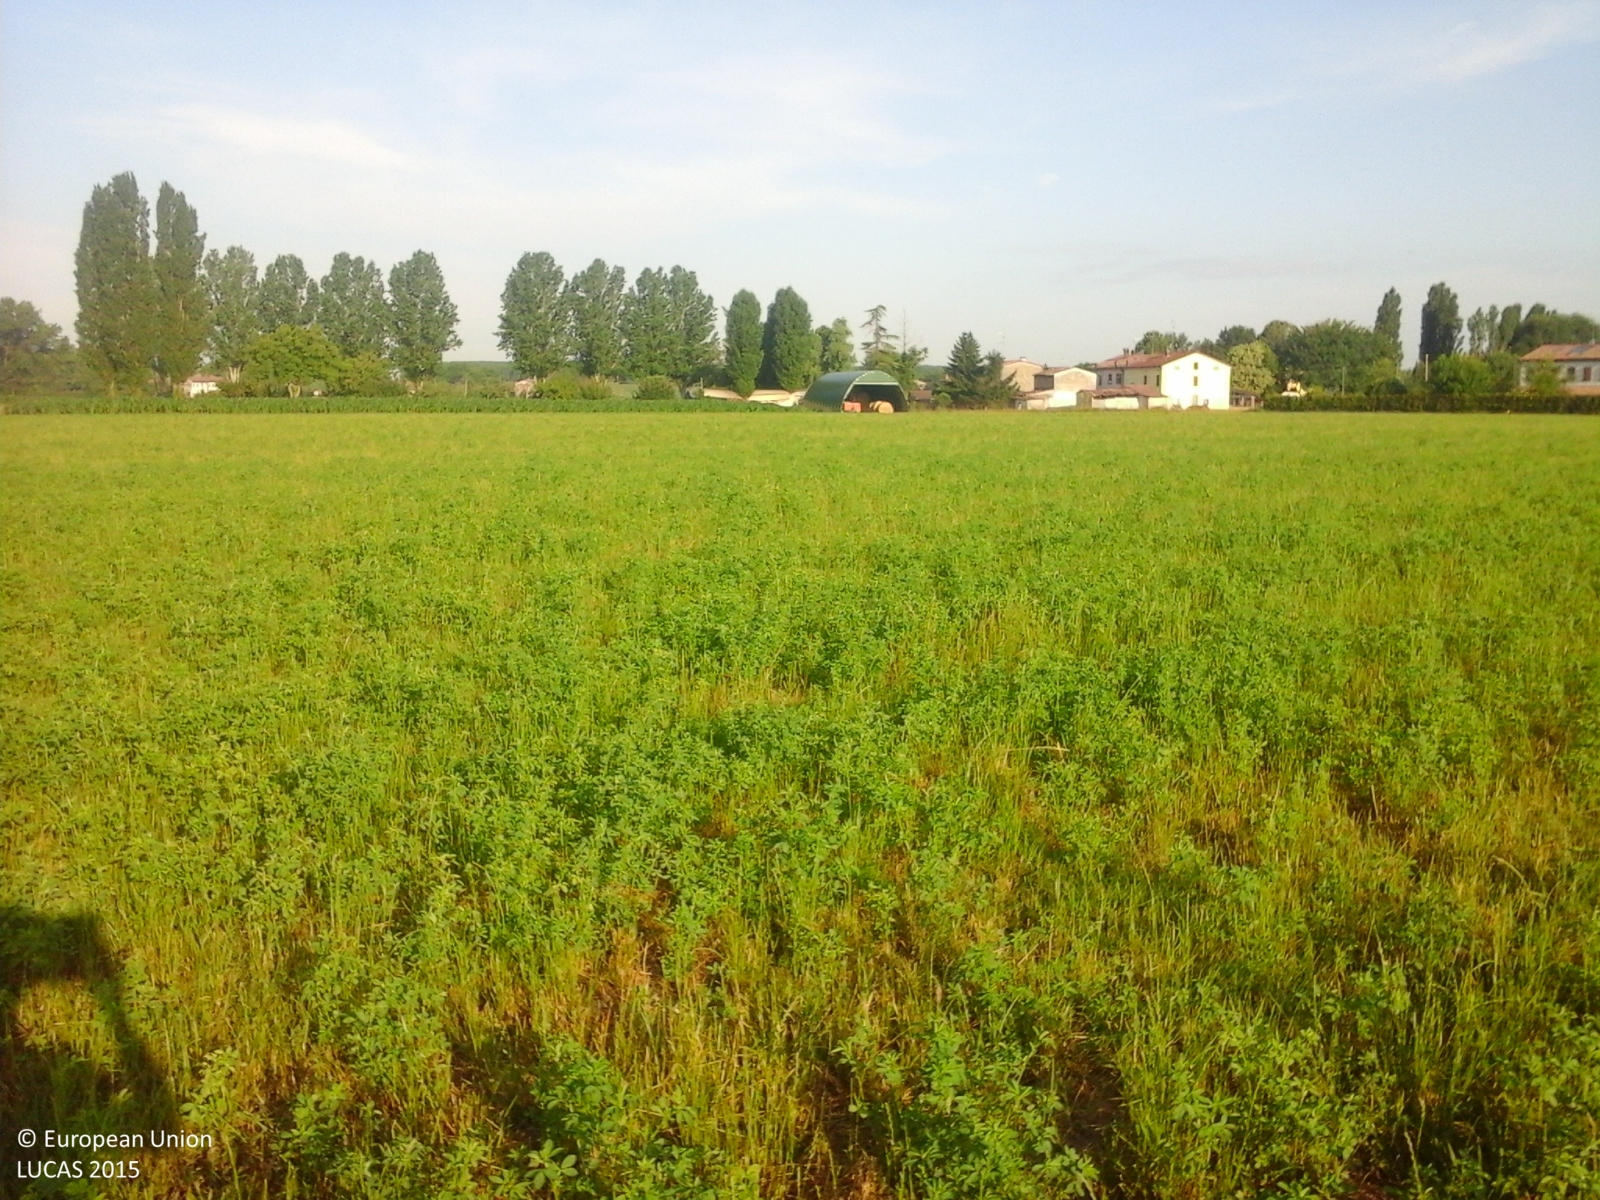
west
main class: Cropland
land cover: Lucerne
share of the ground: > 75 %
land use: Agriculture (excluding fallow land and kitchen gardens)
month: June
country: IT
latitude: 44.9231
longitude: 10.9736
